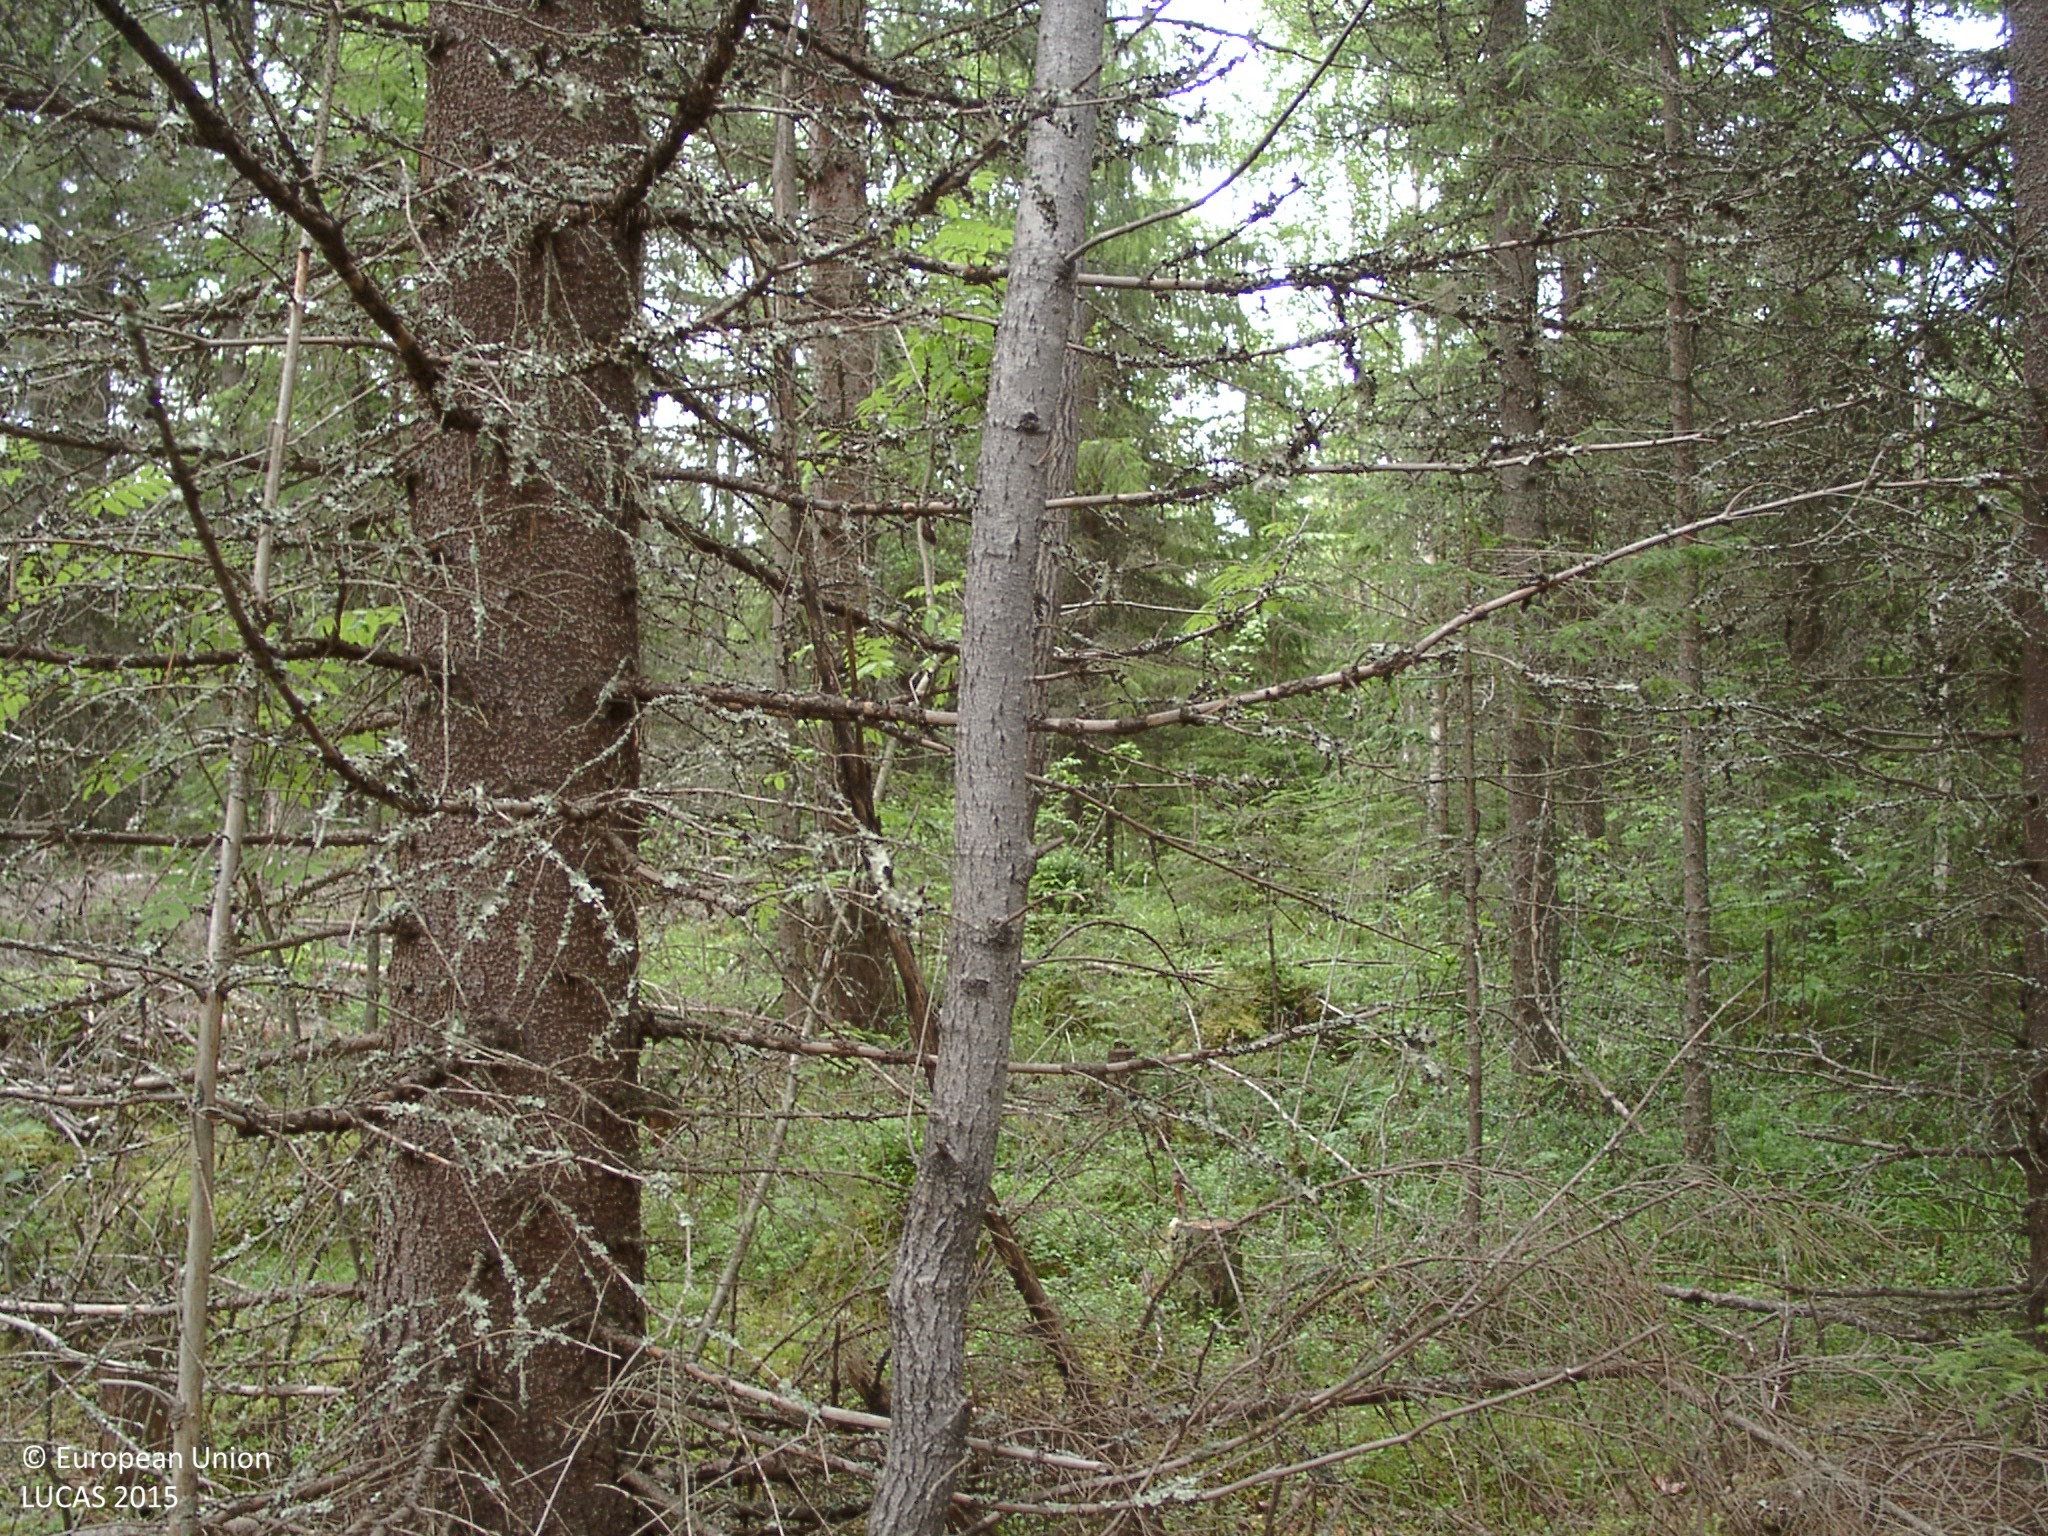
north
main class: Woodland
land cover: Other coniferous woodland
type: boreal forest
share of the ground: 50 - 75 %
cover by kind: coniferous forest trees 55 %, broadleaved forest trees 15 %, shrubs 10 %, herbaceous plants 5 %, lichens and mosses 5 %
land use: Forestry
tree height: > 5 m
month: July
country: FI
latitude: 62.2866
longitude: 25.2781
